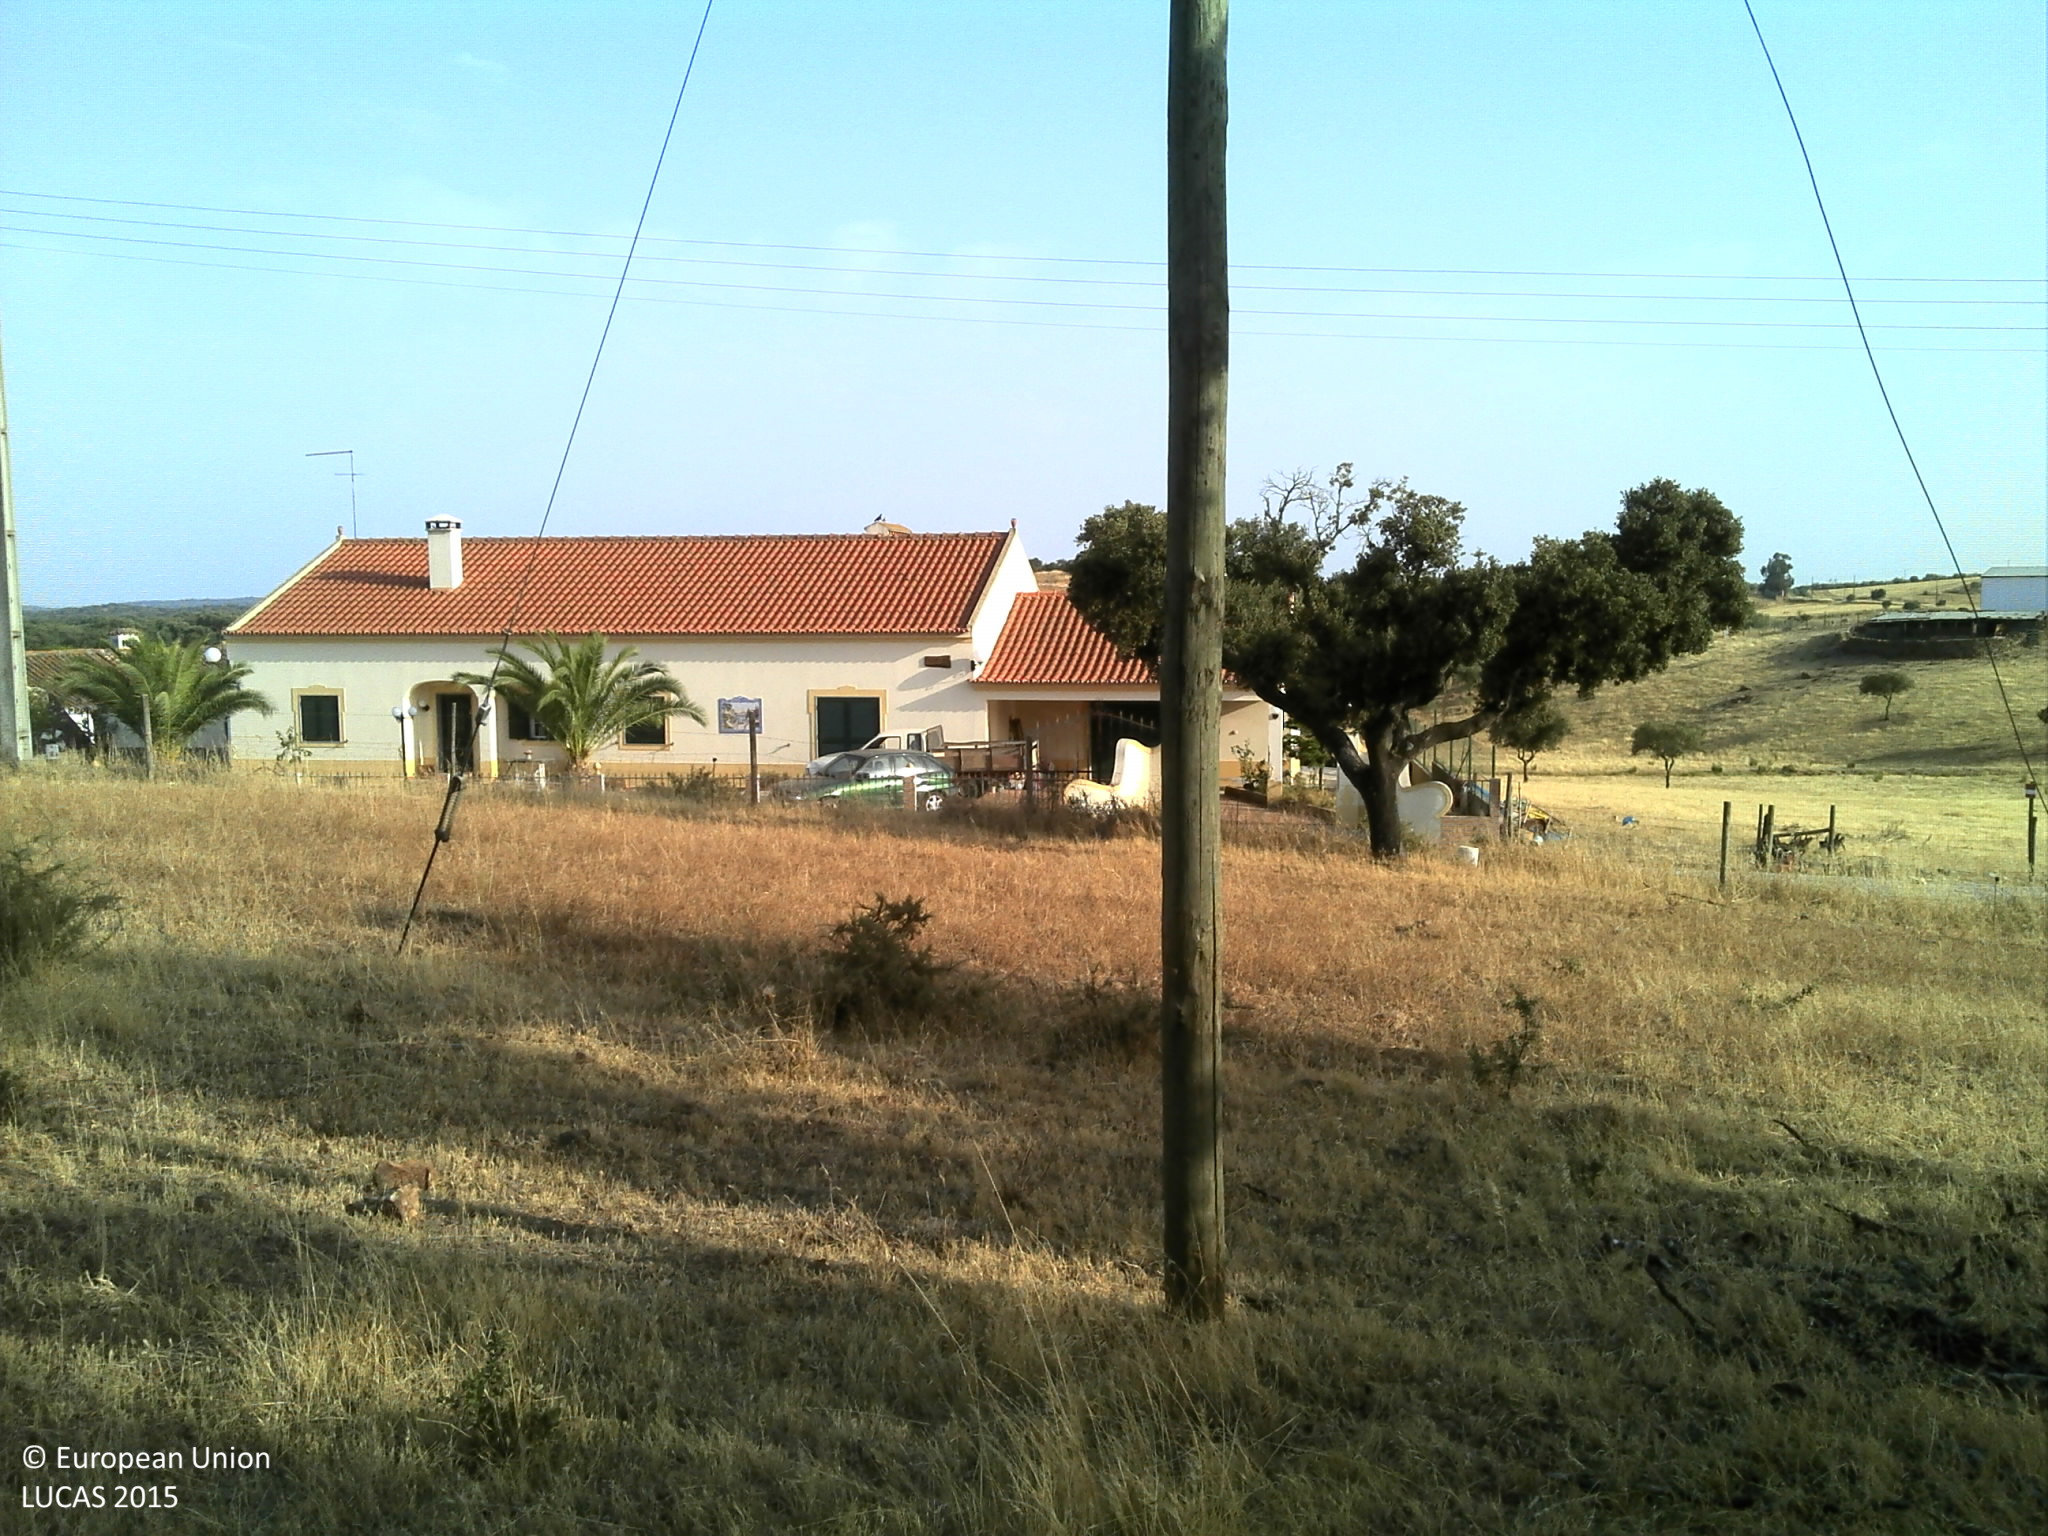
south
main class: Woodland
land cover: Broadleaved woodland
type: broadleaved evergreen forest
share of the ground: 10 - 25 %
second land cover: Grassland without tree/shrub cover
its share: 10 - 25 %
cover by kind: unconsolidated bare surface 80 %, broadleaved forest trees 10 %, herbaceous plants 10 %
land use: Forestry
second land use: Agriculture (excluding fallow land and kitchen gardens)
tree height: > 5 m
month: July
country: PT
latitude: 38.6754
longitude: -7.3269
